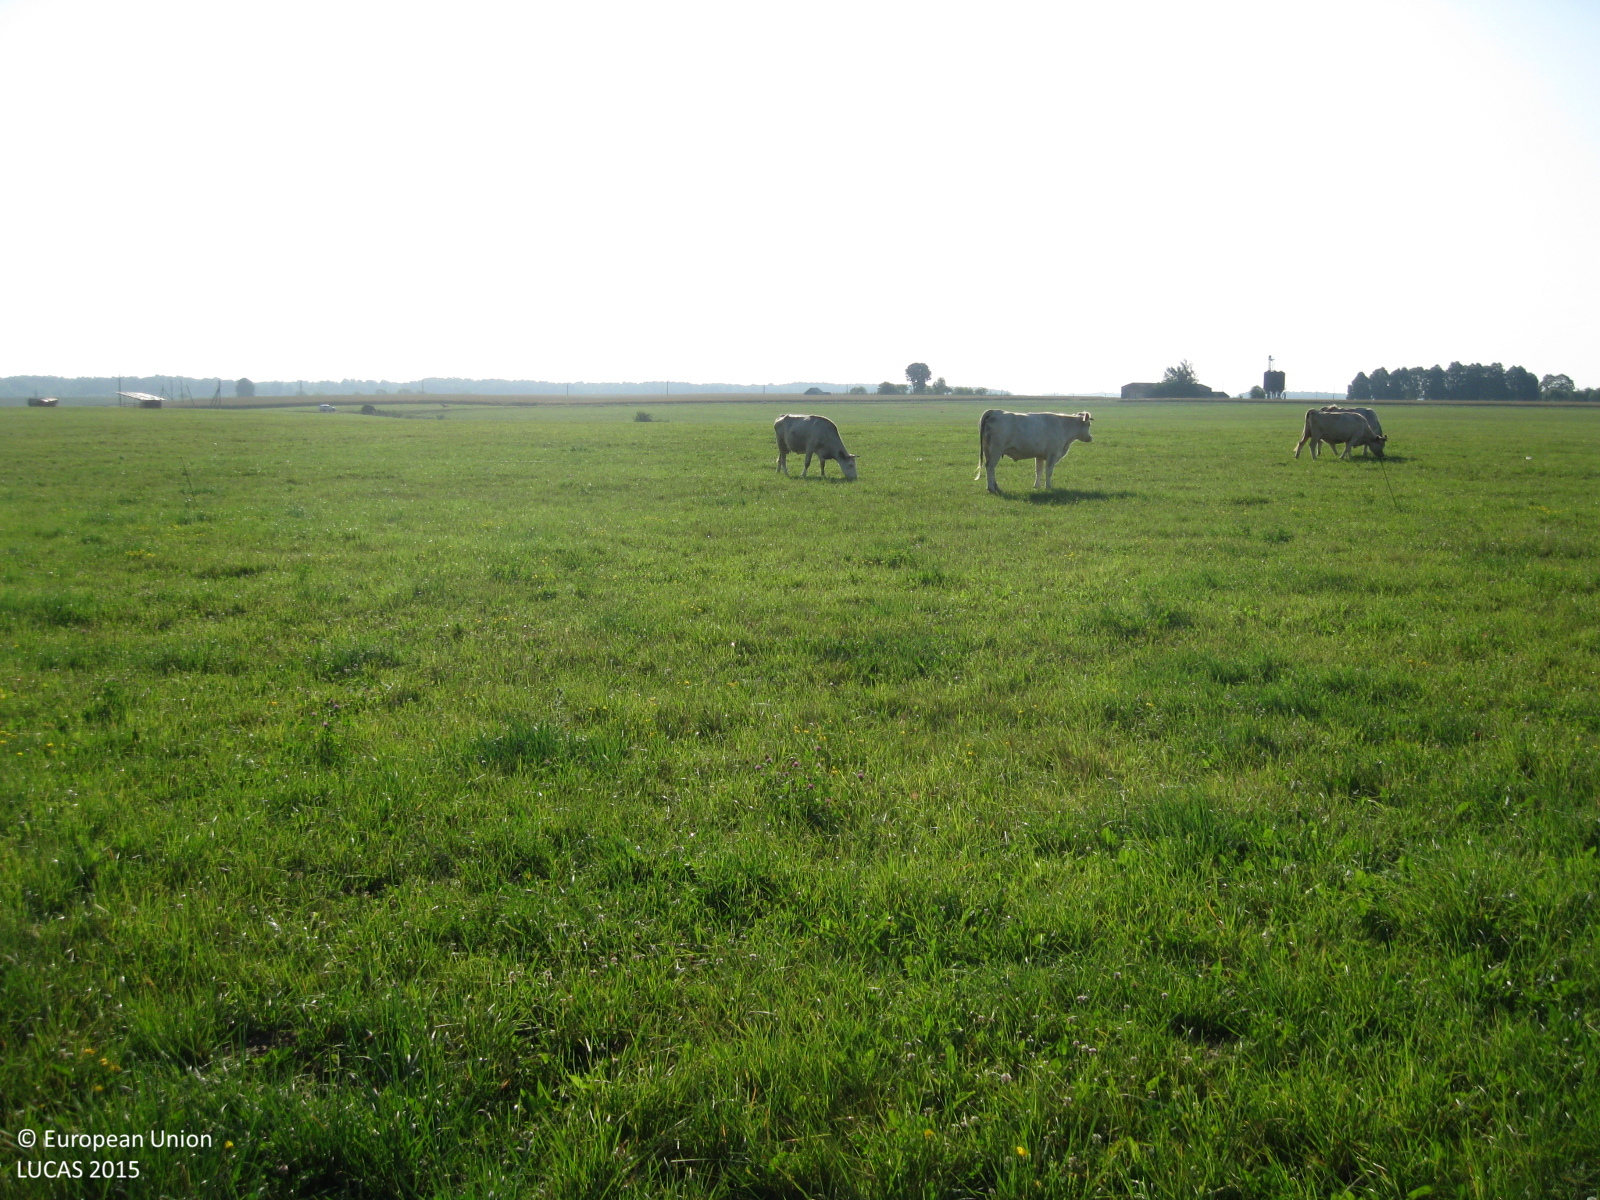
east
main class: Grassland
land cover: Grassland without tree/shrub cover
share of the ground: > 75 %
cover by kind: herbaceous plants 100 %
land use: Agriculture (excluding fallow land and kitchen gardens)
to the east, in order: Grassland without tree/shrub cover; Fences; Grassland without tree/shrub cover
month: July
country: LT
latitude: 55.2767
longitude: 24.5690
